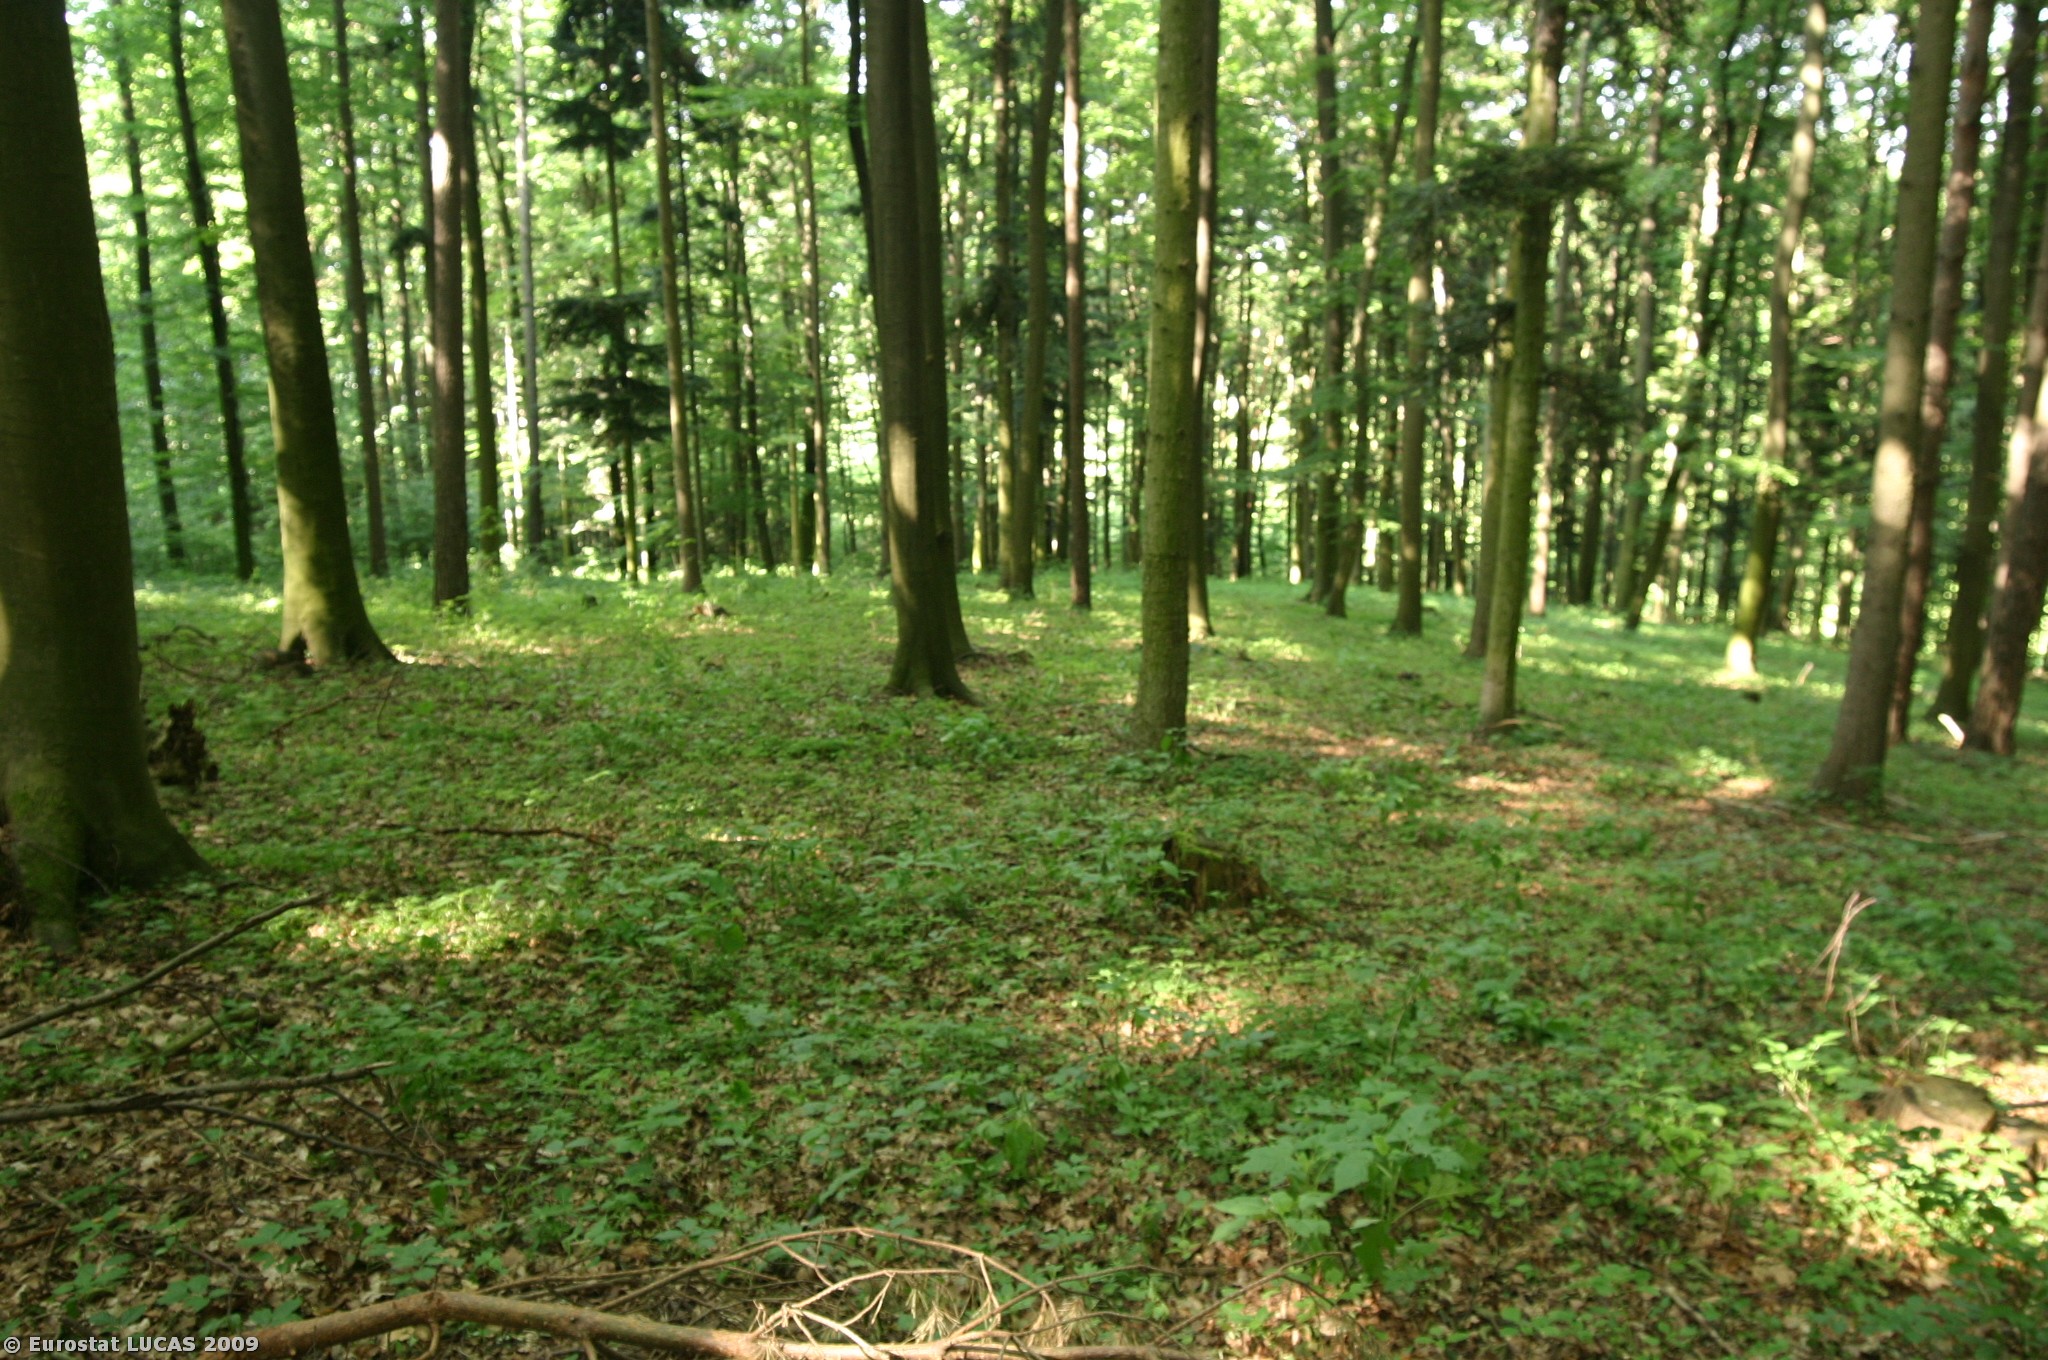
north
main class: Woodland
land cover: Broadleaved woodland
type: hemiboreal forest and nemoral coniferous forest and mixed broadleaved-coniferous forest
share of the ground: > 75 %
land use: Forestry
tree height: > 5 m
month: May
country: AT
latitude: 48.2437
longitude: 15.9421
